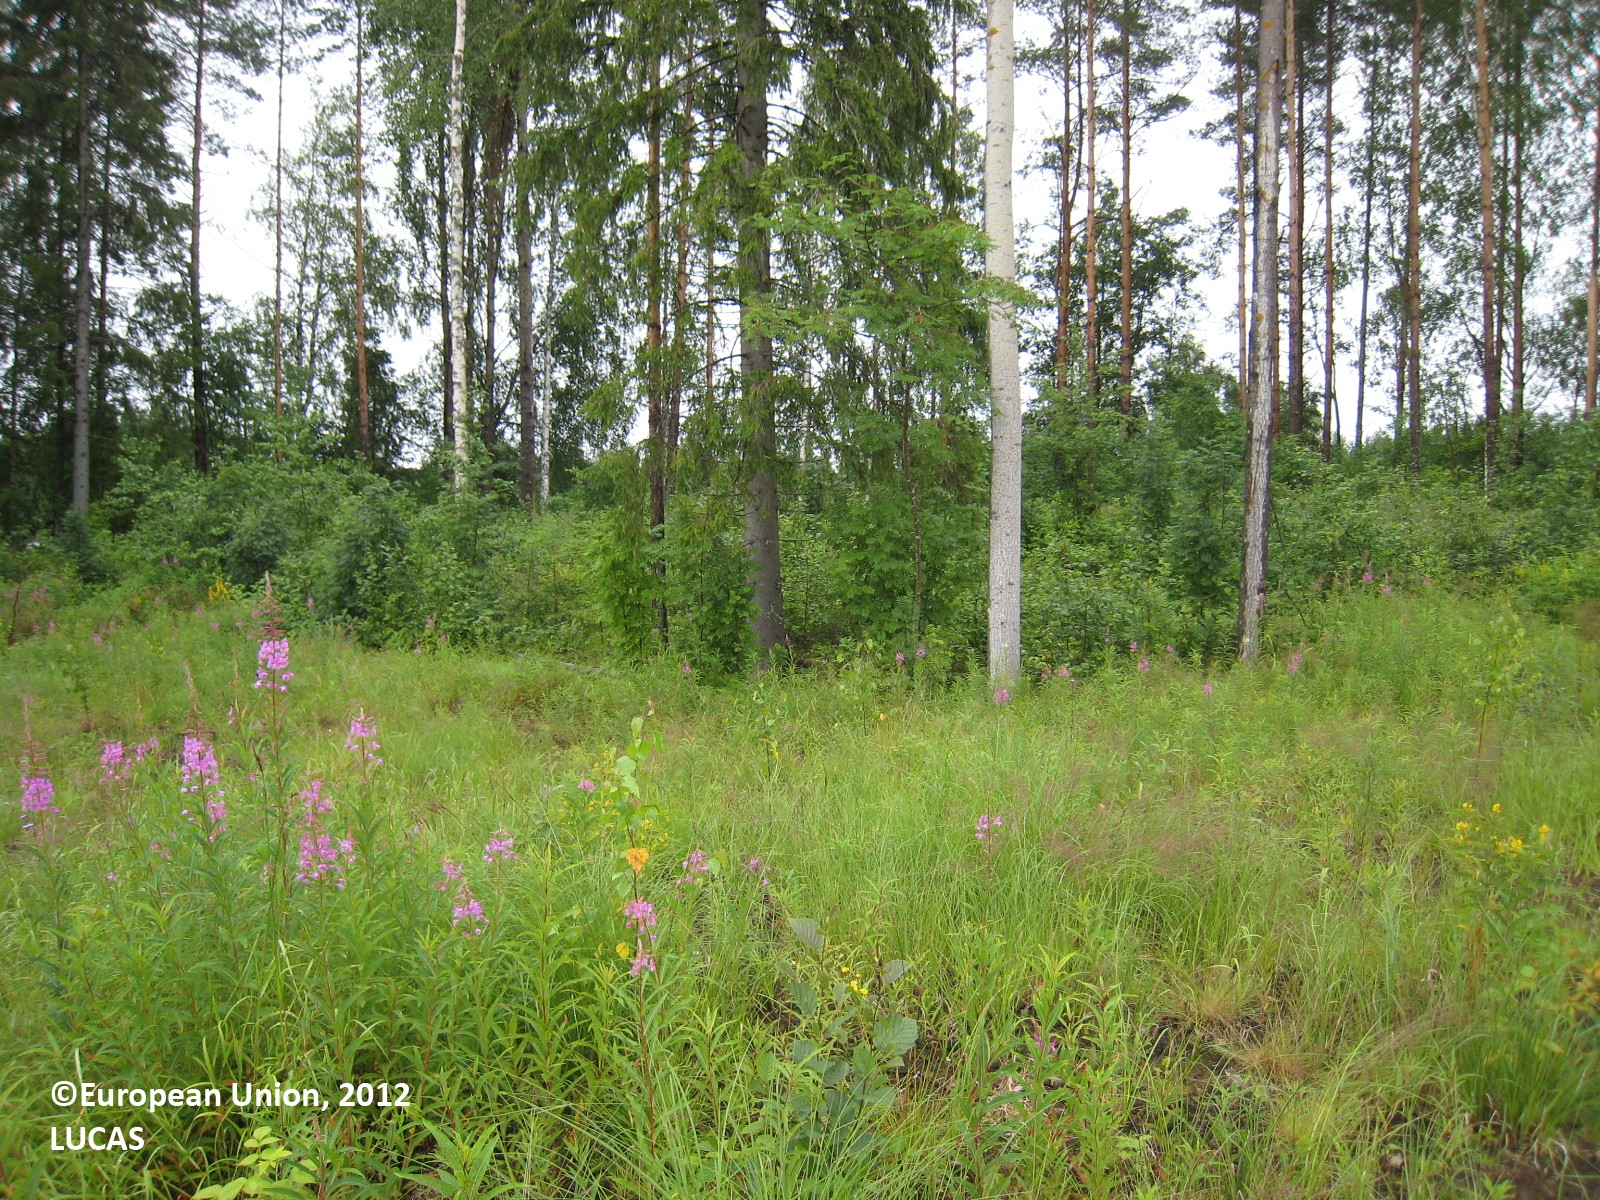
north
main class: Grassland
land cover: Grassland with sparse tree/shrub cover
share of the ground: > 75 %
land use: Amenities, museums, leisure
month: July
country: FI
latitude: 62.9179
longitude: 26.2917
